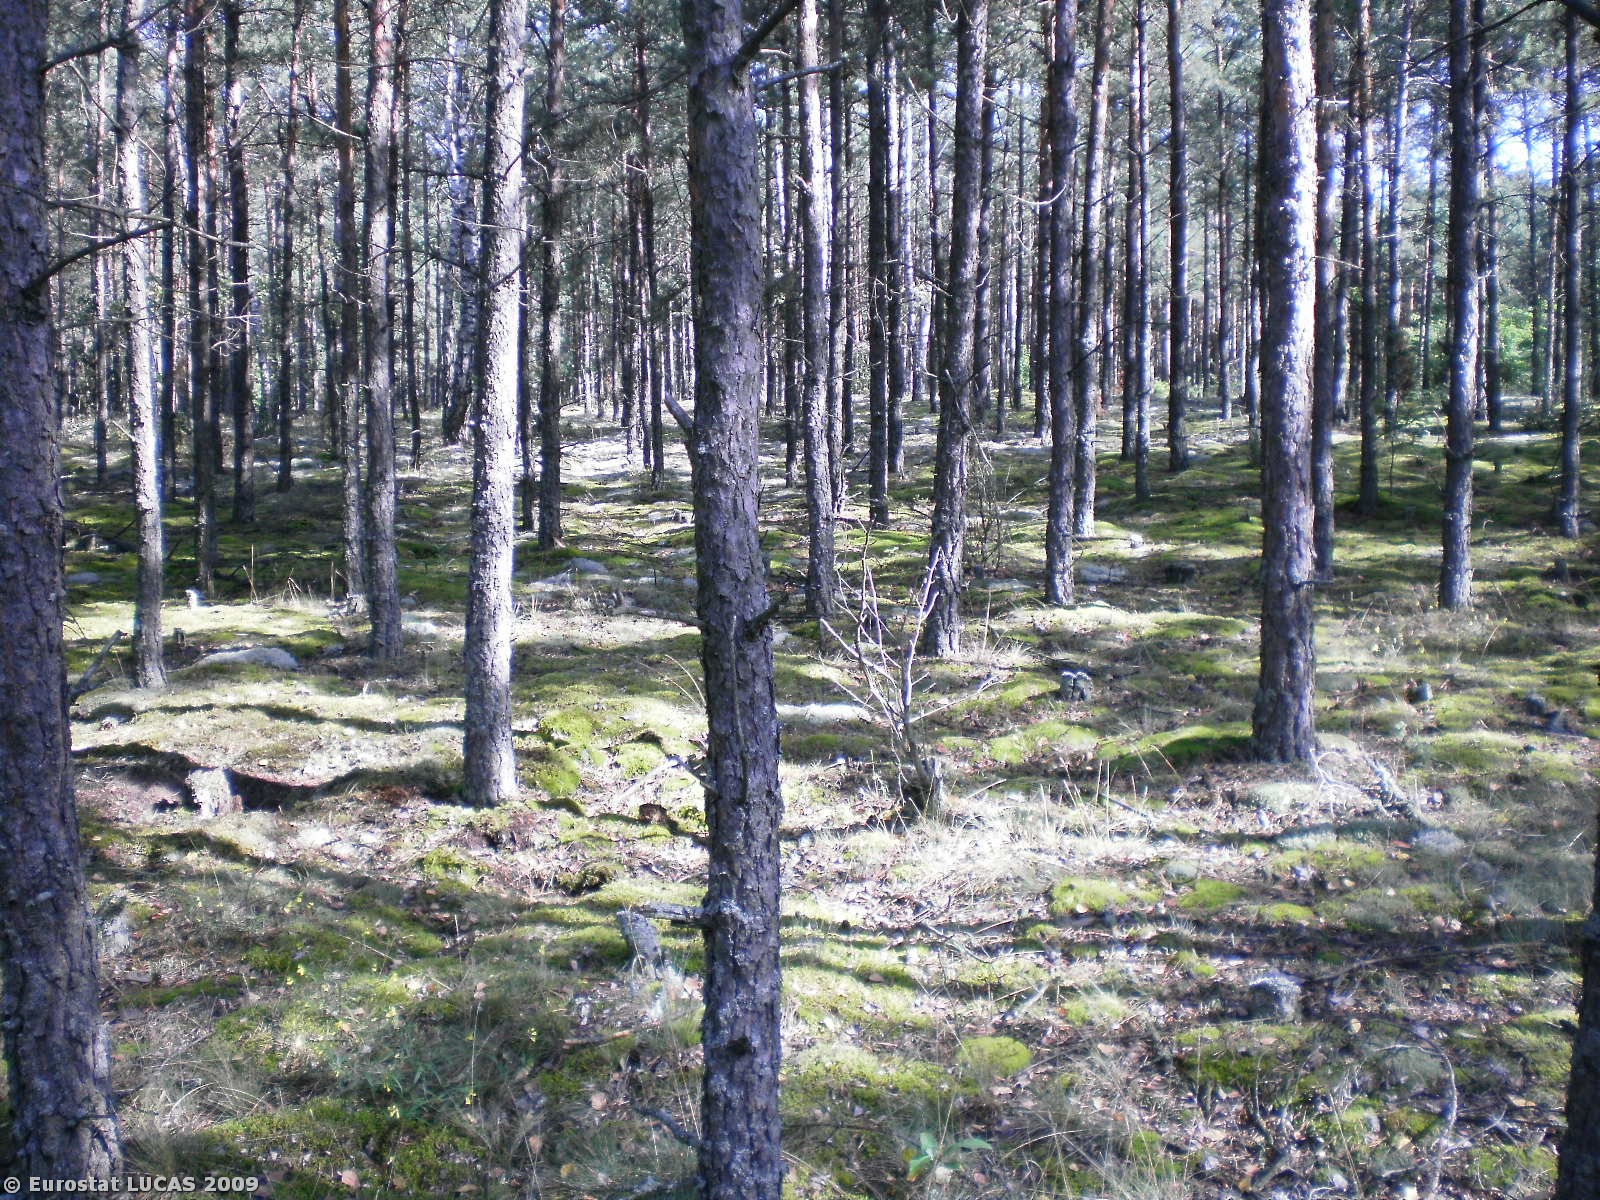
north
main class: Woodland
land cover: Coniferous woodland
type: hemiboreal forest and nemoral coniferous forest and mixed broadleaved-coniferous forest
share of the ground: > 75 %
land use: Forestry
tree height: > 5 m
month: August
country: PL
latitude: 53.1970
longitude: 21.5016
